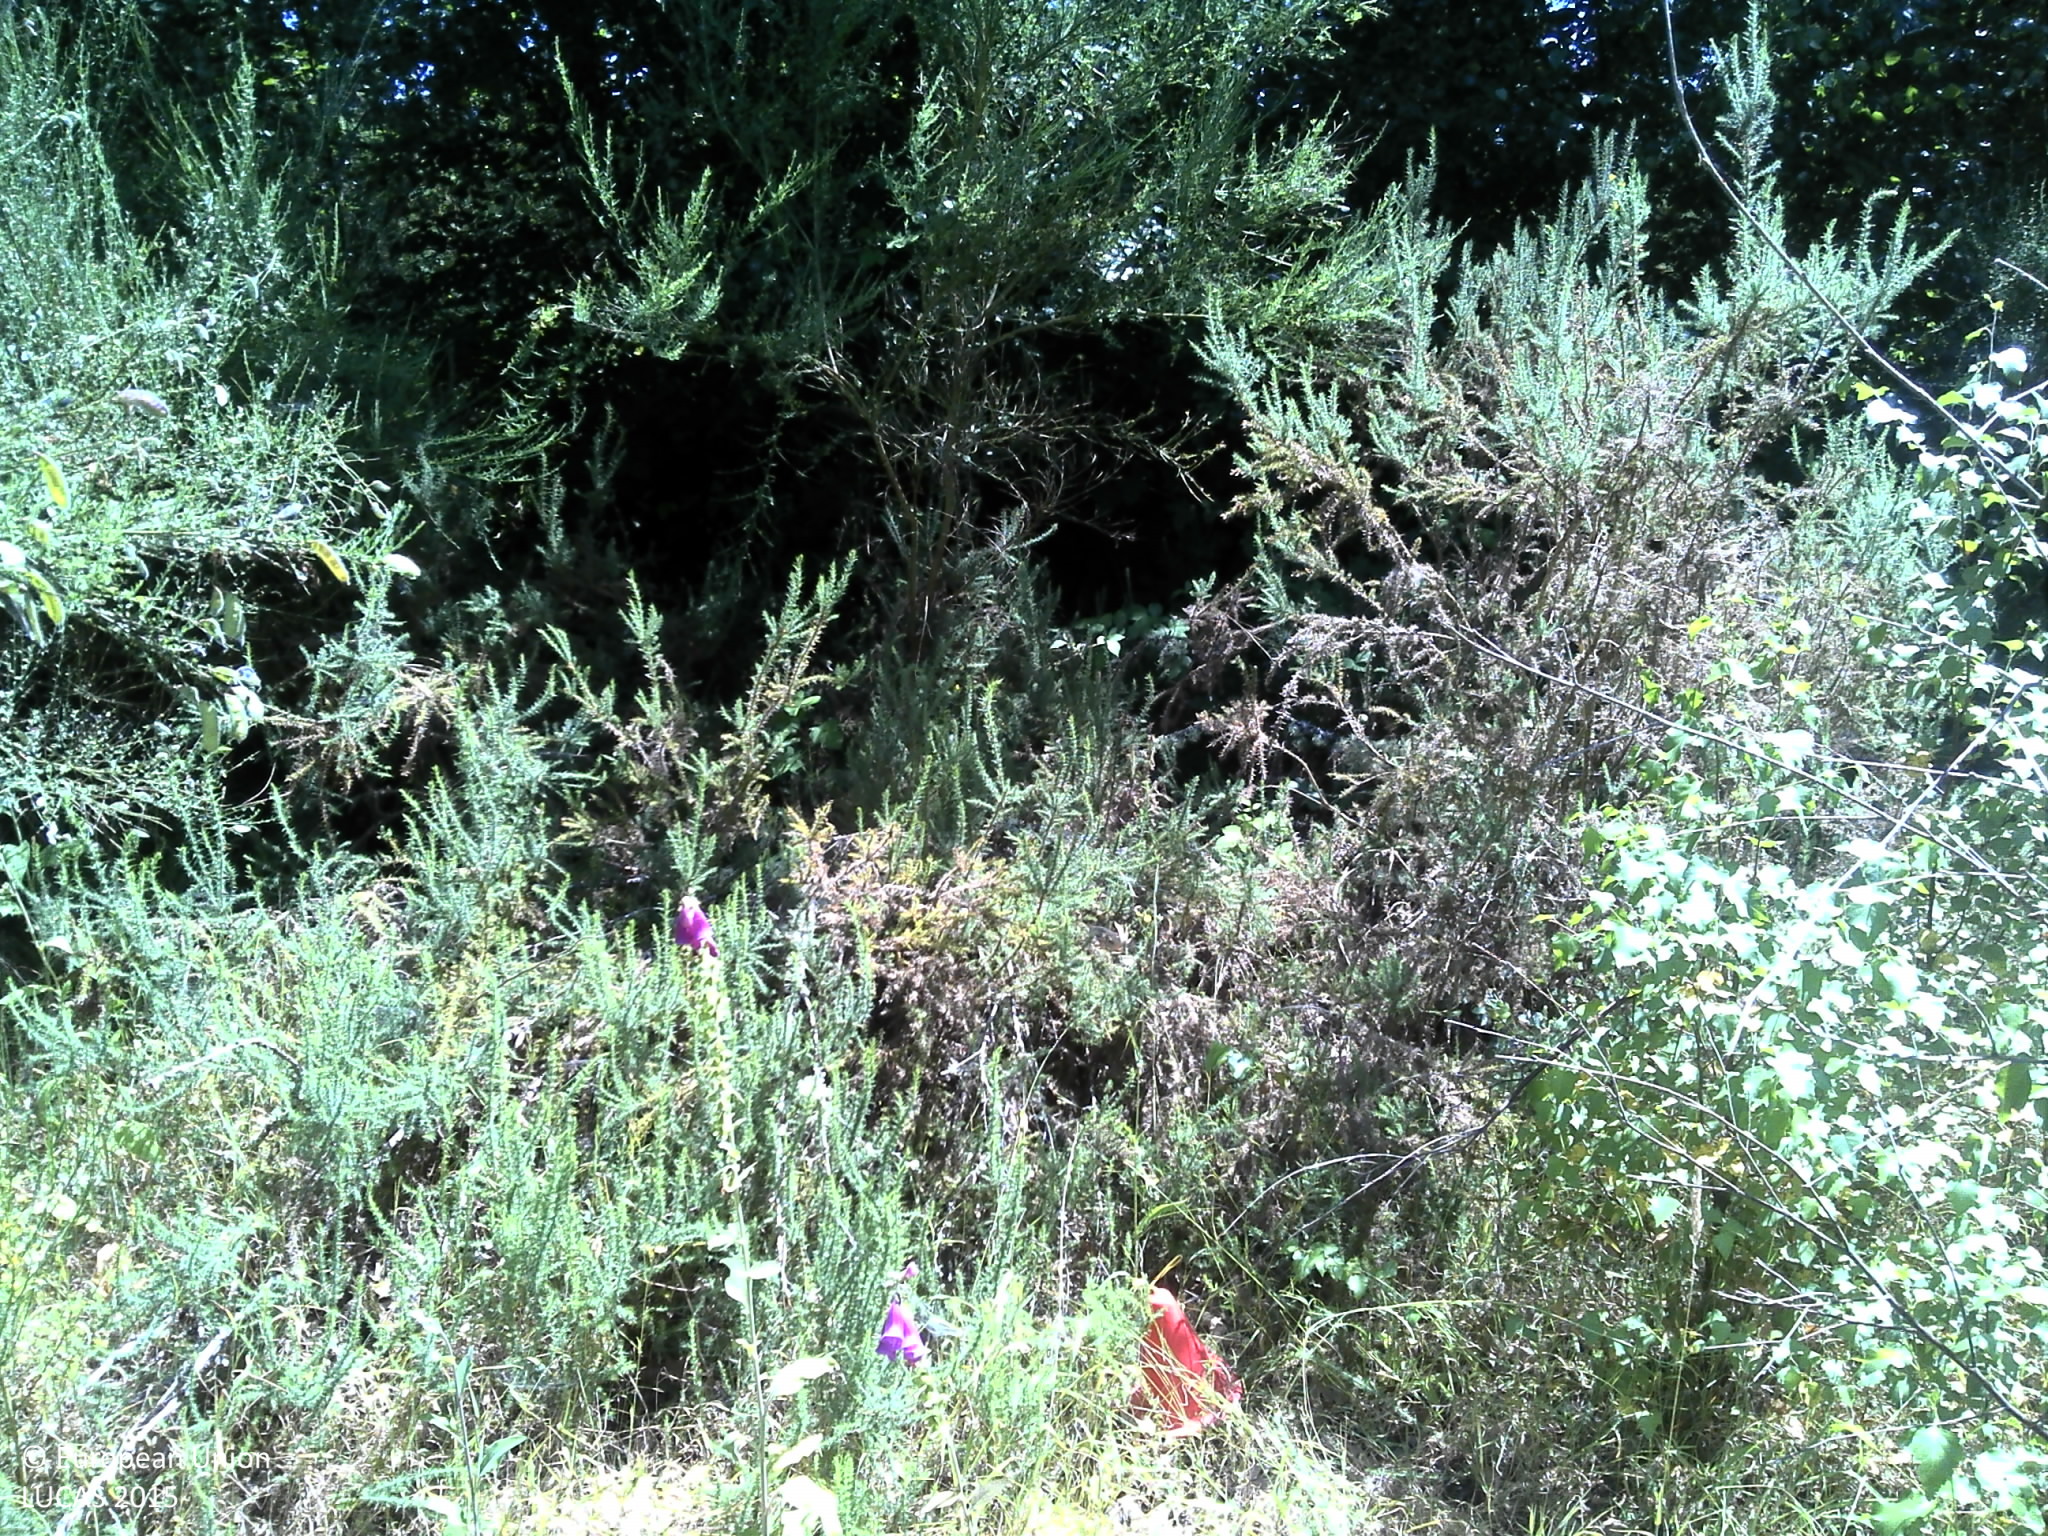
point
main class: Grassland
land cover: Grassland with sparse tree/shrub cover
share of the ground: > 75 %
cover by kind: herbaceous plants 85 %, unconsolidated bare surface 10 %, broadleaved forest trees 5 %
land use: Agriculture (excluding fallow land and kitchen gardens)
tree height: > 5 m
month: July
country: PT
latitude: 41.8214
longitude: -7.5791
